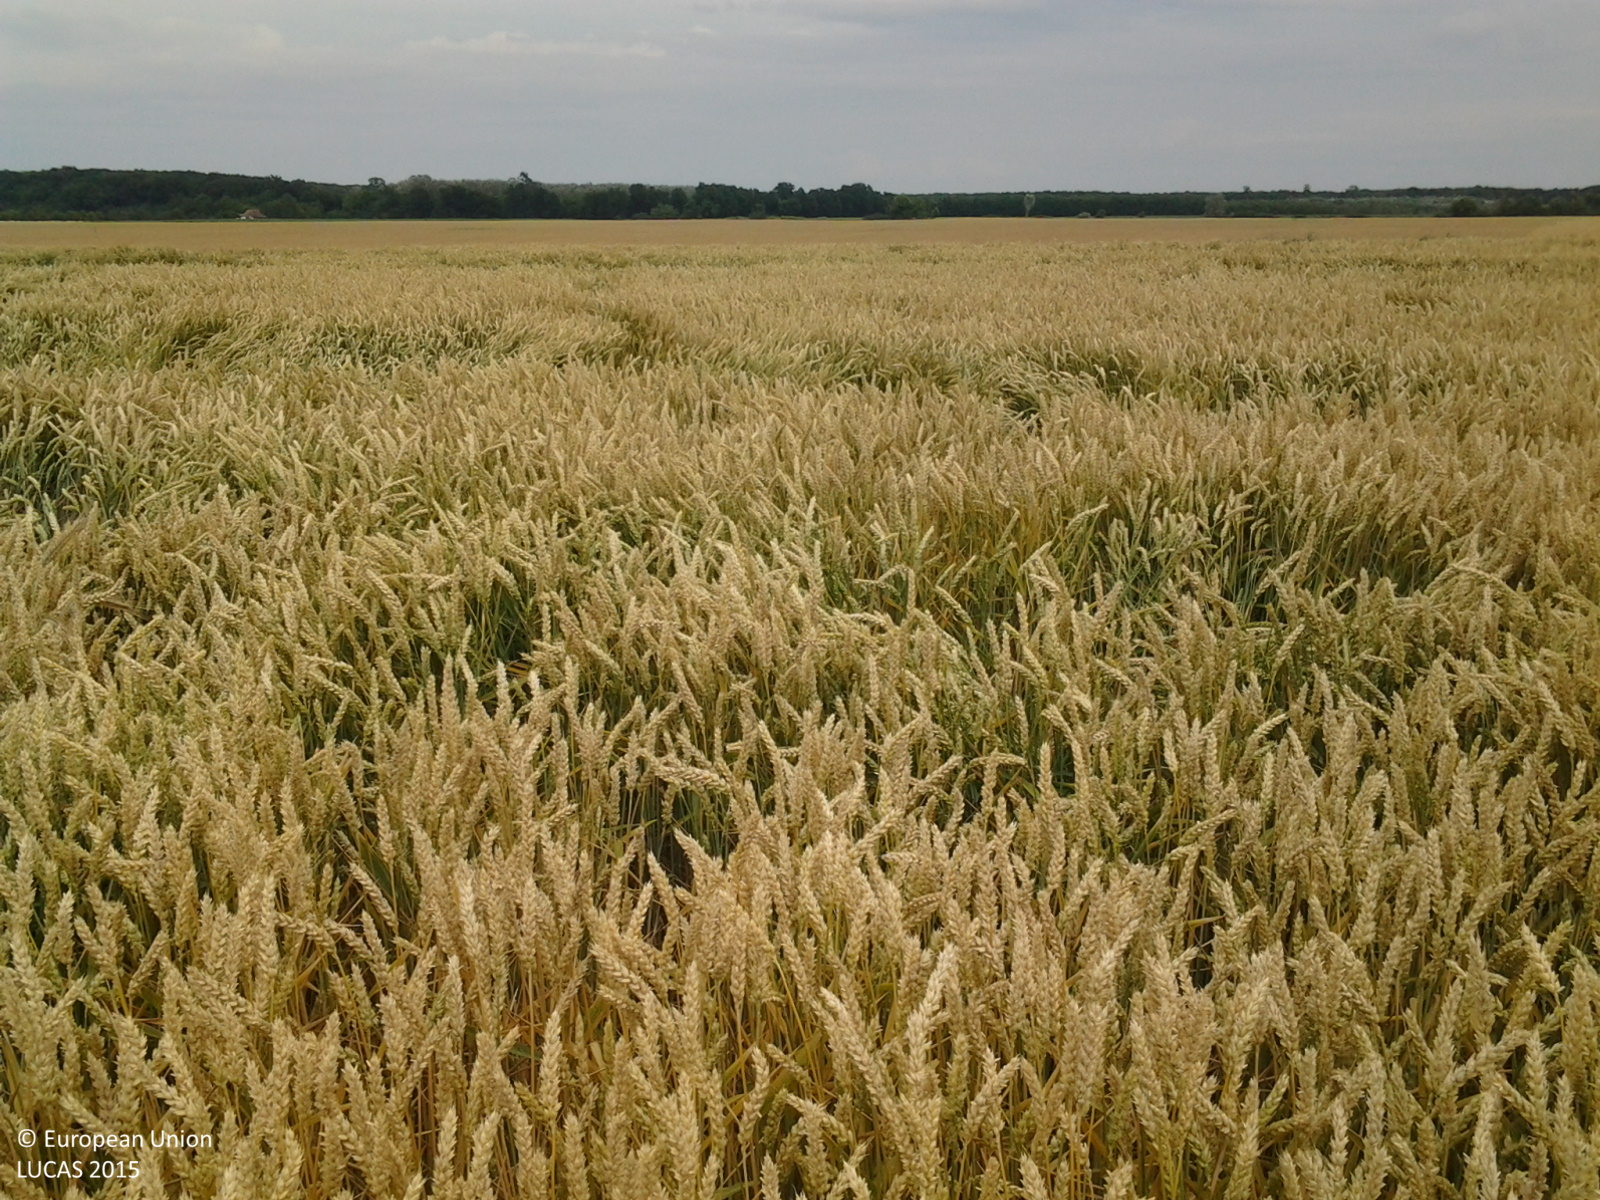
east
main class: Cropland
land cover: Common wheat
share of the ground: > 75 %
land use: Agriculture (excluding fallow land and kitchen gardens)
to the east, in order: Common wheat; Ditches and canals; Common wheat
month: June
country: HU
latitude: 46.7602
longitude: 21.2037
